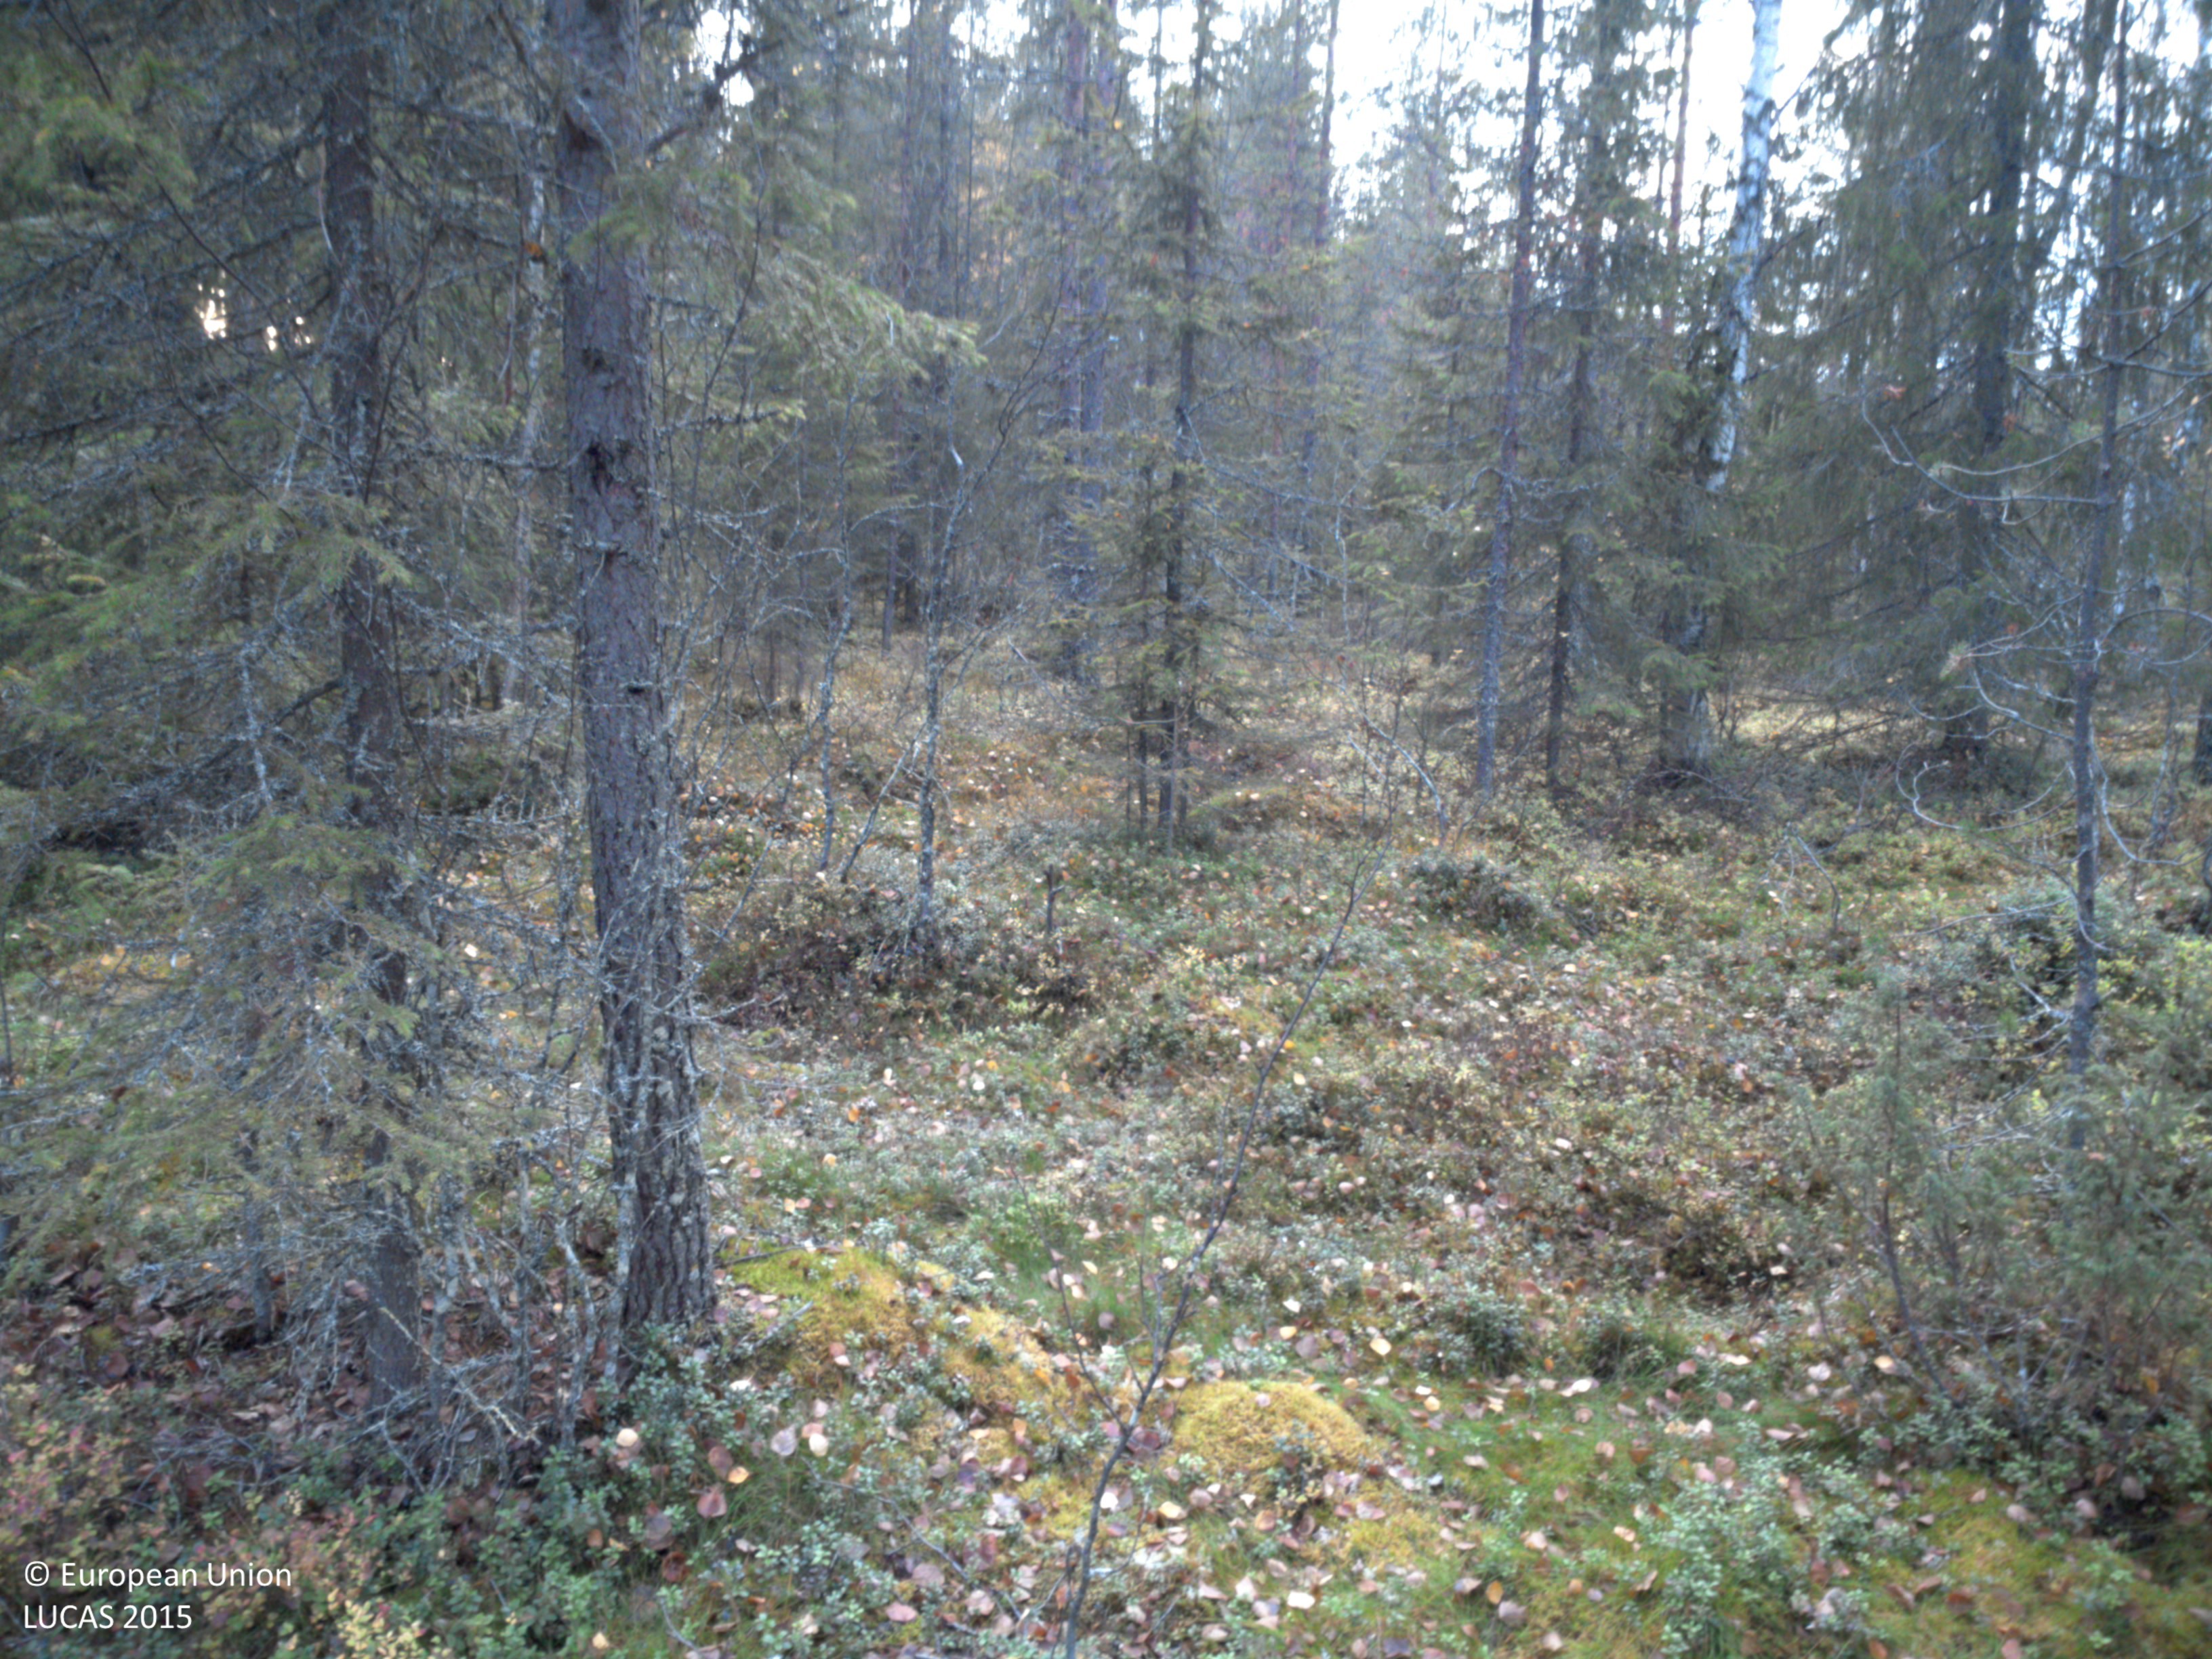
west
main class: Woodland
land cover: Pine dominated mixed woodland
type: boreal forest
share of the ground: > 75 %
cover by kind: coniferous forest trees 60 %, broadleaved forest trees 20 %, shrubs 15 %, lichens and mosses 5 %
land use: Forestry
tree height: > 5 m
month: September
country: SE
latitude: 65.0373
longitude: 18.6073
